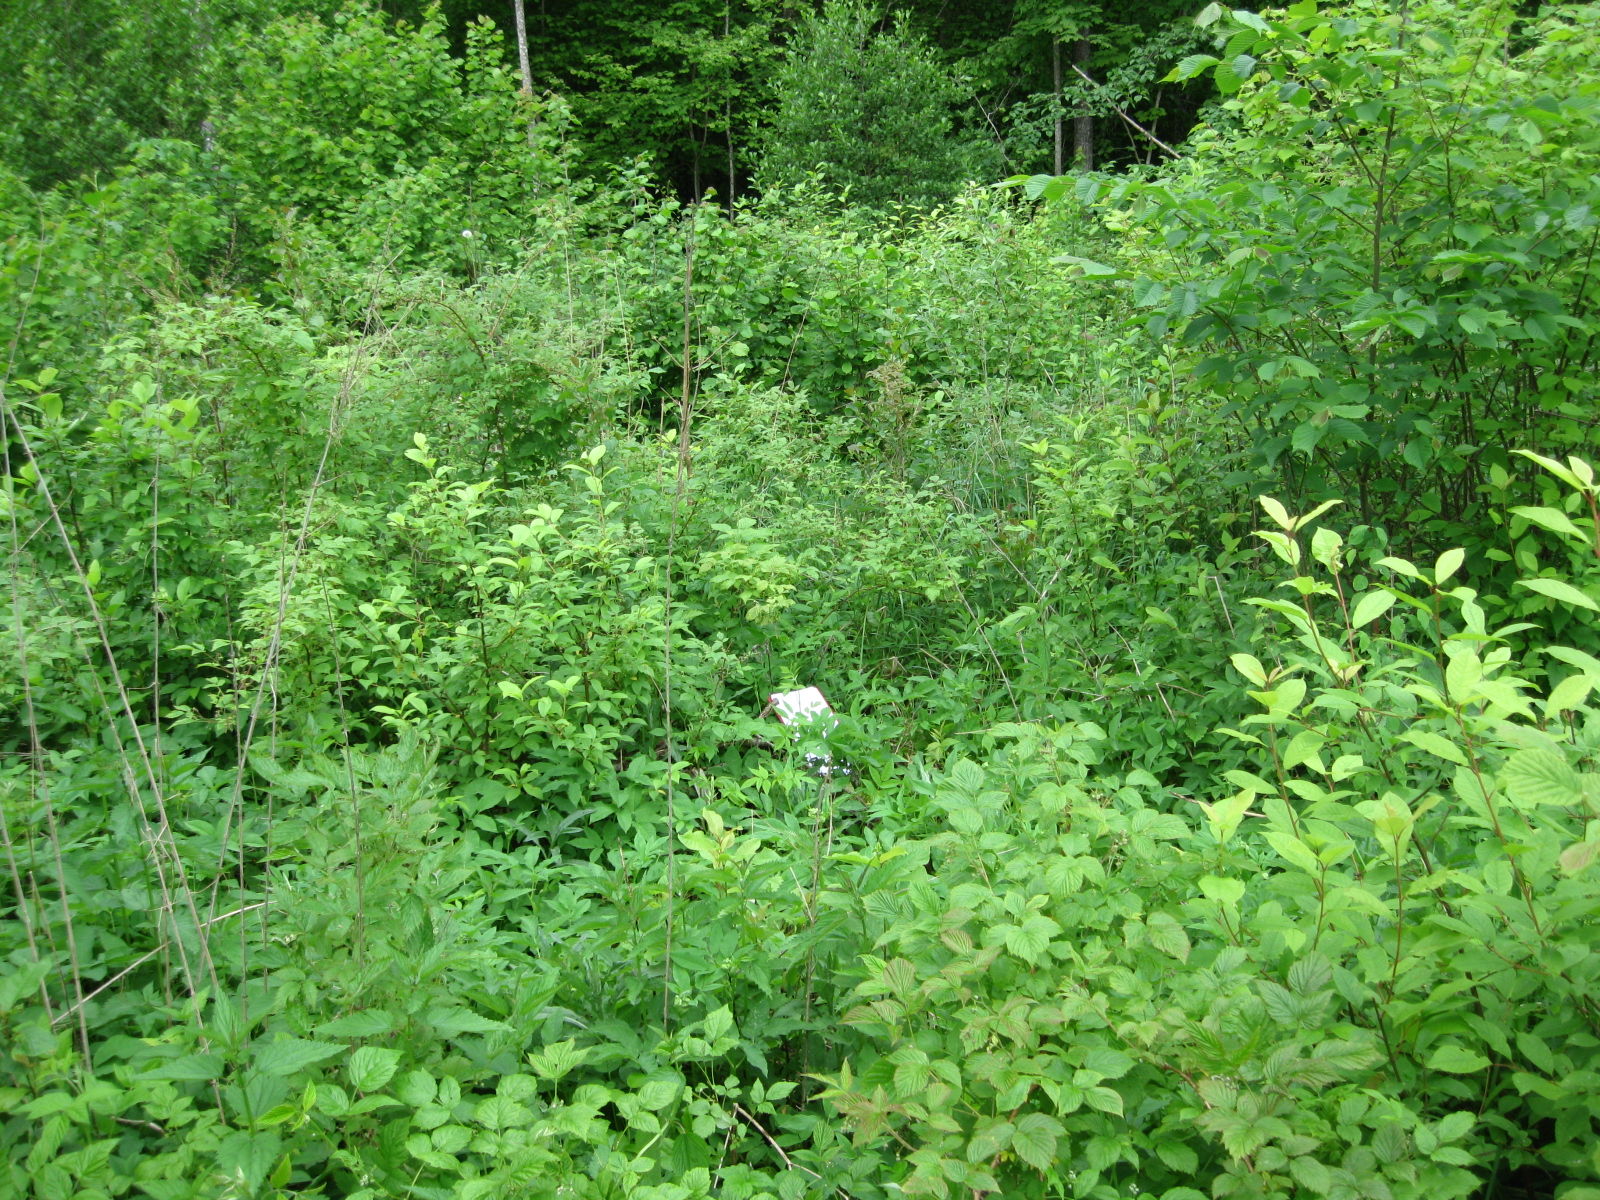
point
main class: Woodland
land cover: Broadleaved woodland
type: non-riverine alder, birch or aspen forest
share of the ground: > 75 %
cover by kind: broadleaved forest trees 80 %, shrubs 15 %, herbaceous plants 5 %
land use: Forestry
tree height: < 5 m
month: June
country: LT
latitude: 55.8817
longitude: 24.0770
